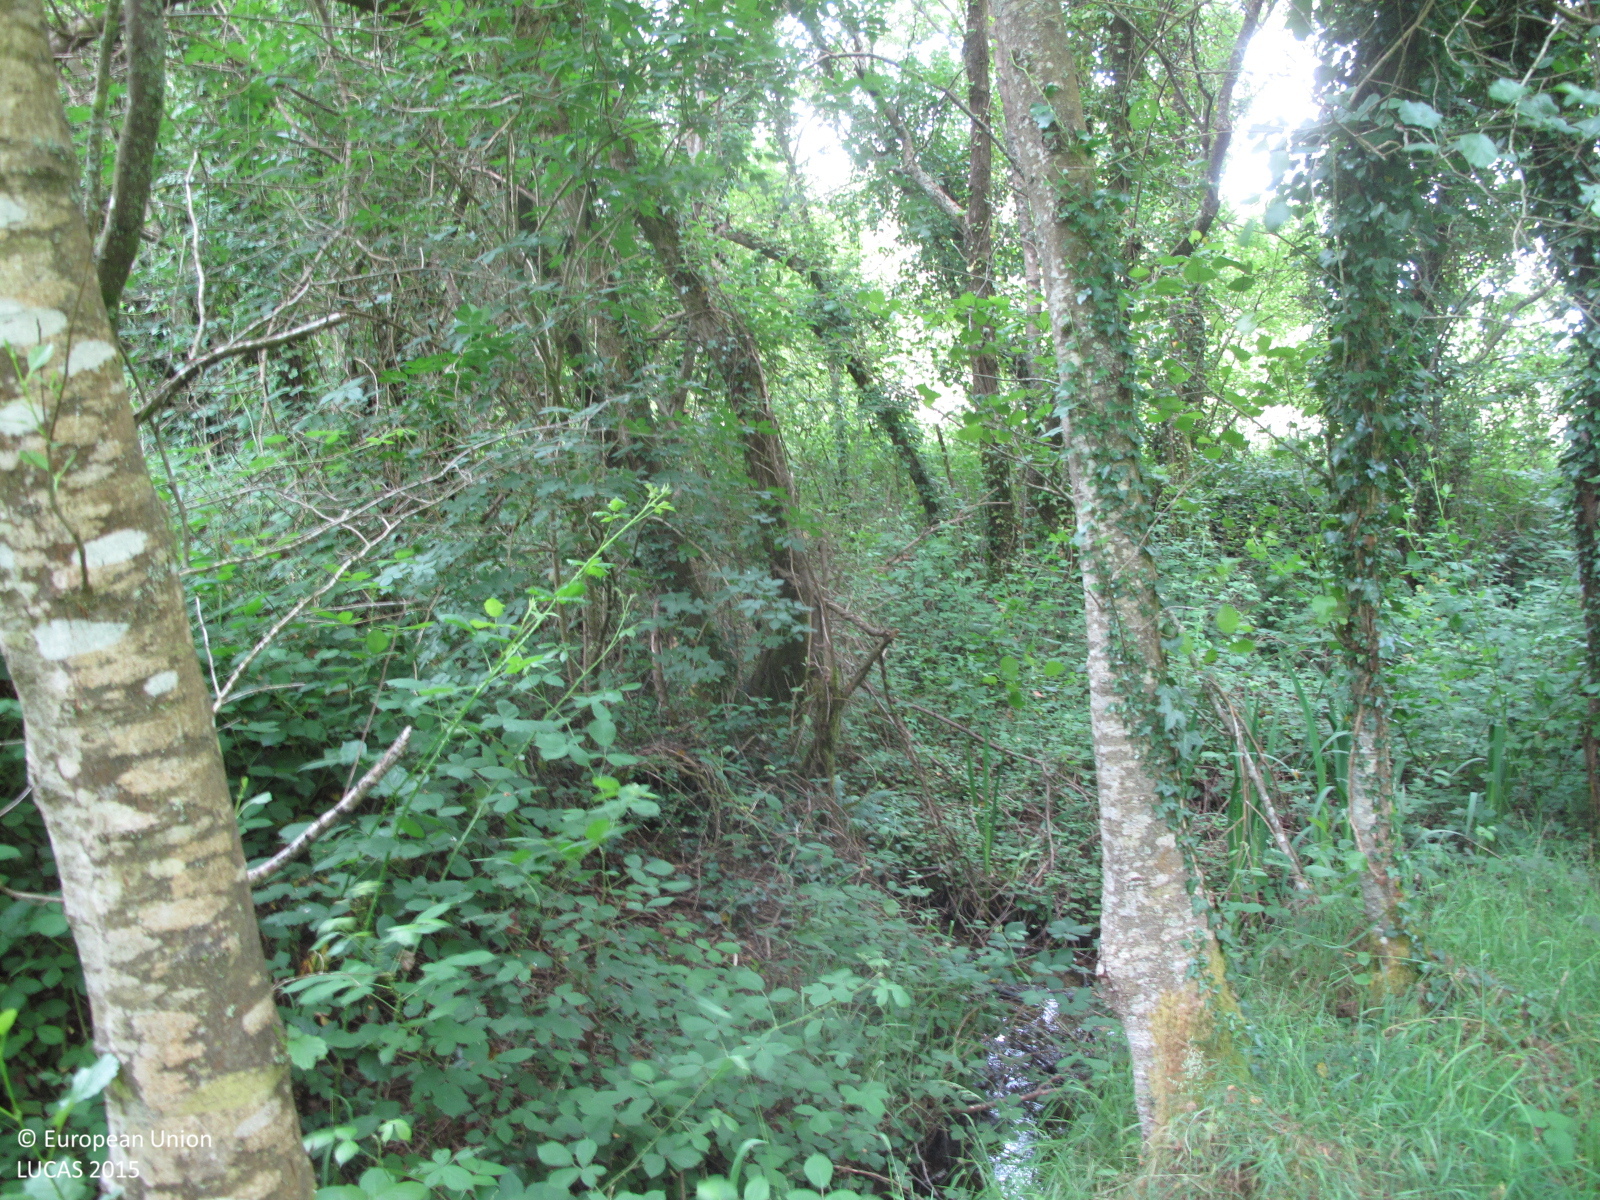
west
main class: Woodland
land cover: Broadleaved woodland
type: acidophilous oak and oak-birch forest
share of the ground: > 75 %
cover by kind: broadleaved forest trees 90 %, shrubs 5 %, herbaceous plants 5 %
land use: Semi-natural and natural areas not in use
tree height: > 5 m
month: June
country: ES
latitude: 43.1378
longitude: -8.5625
